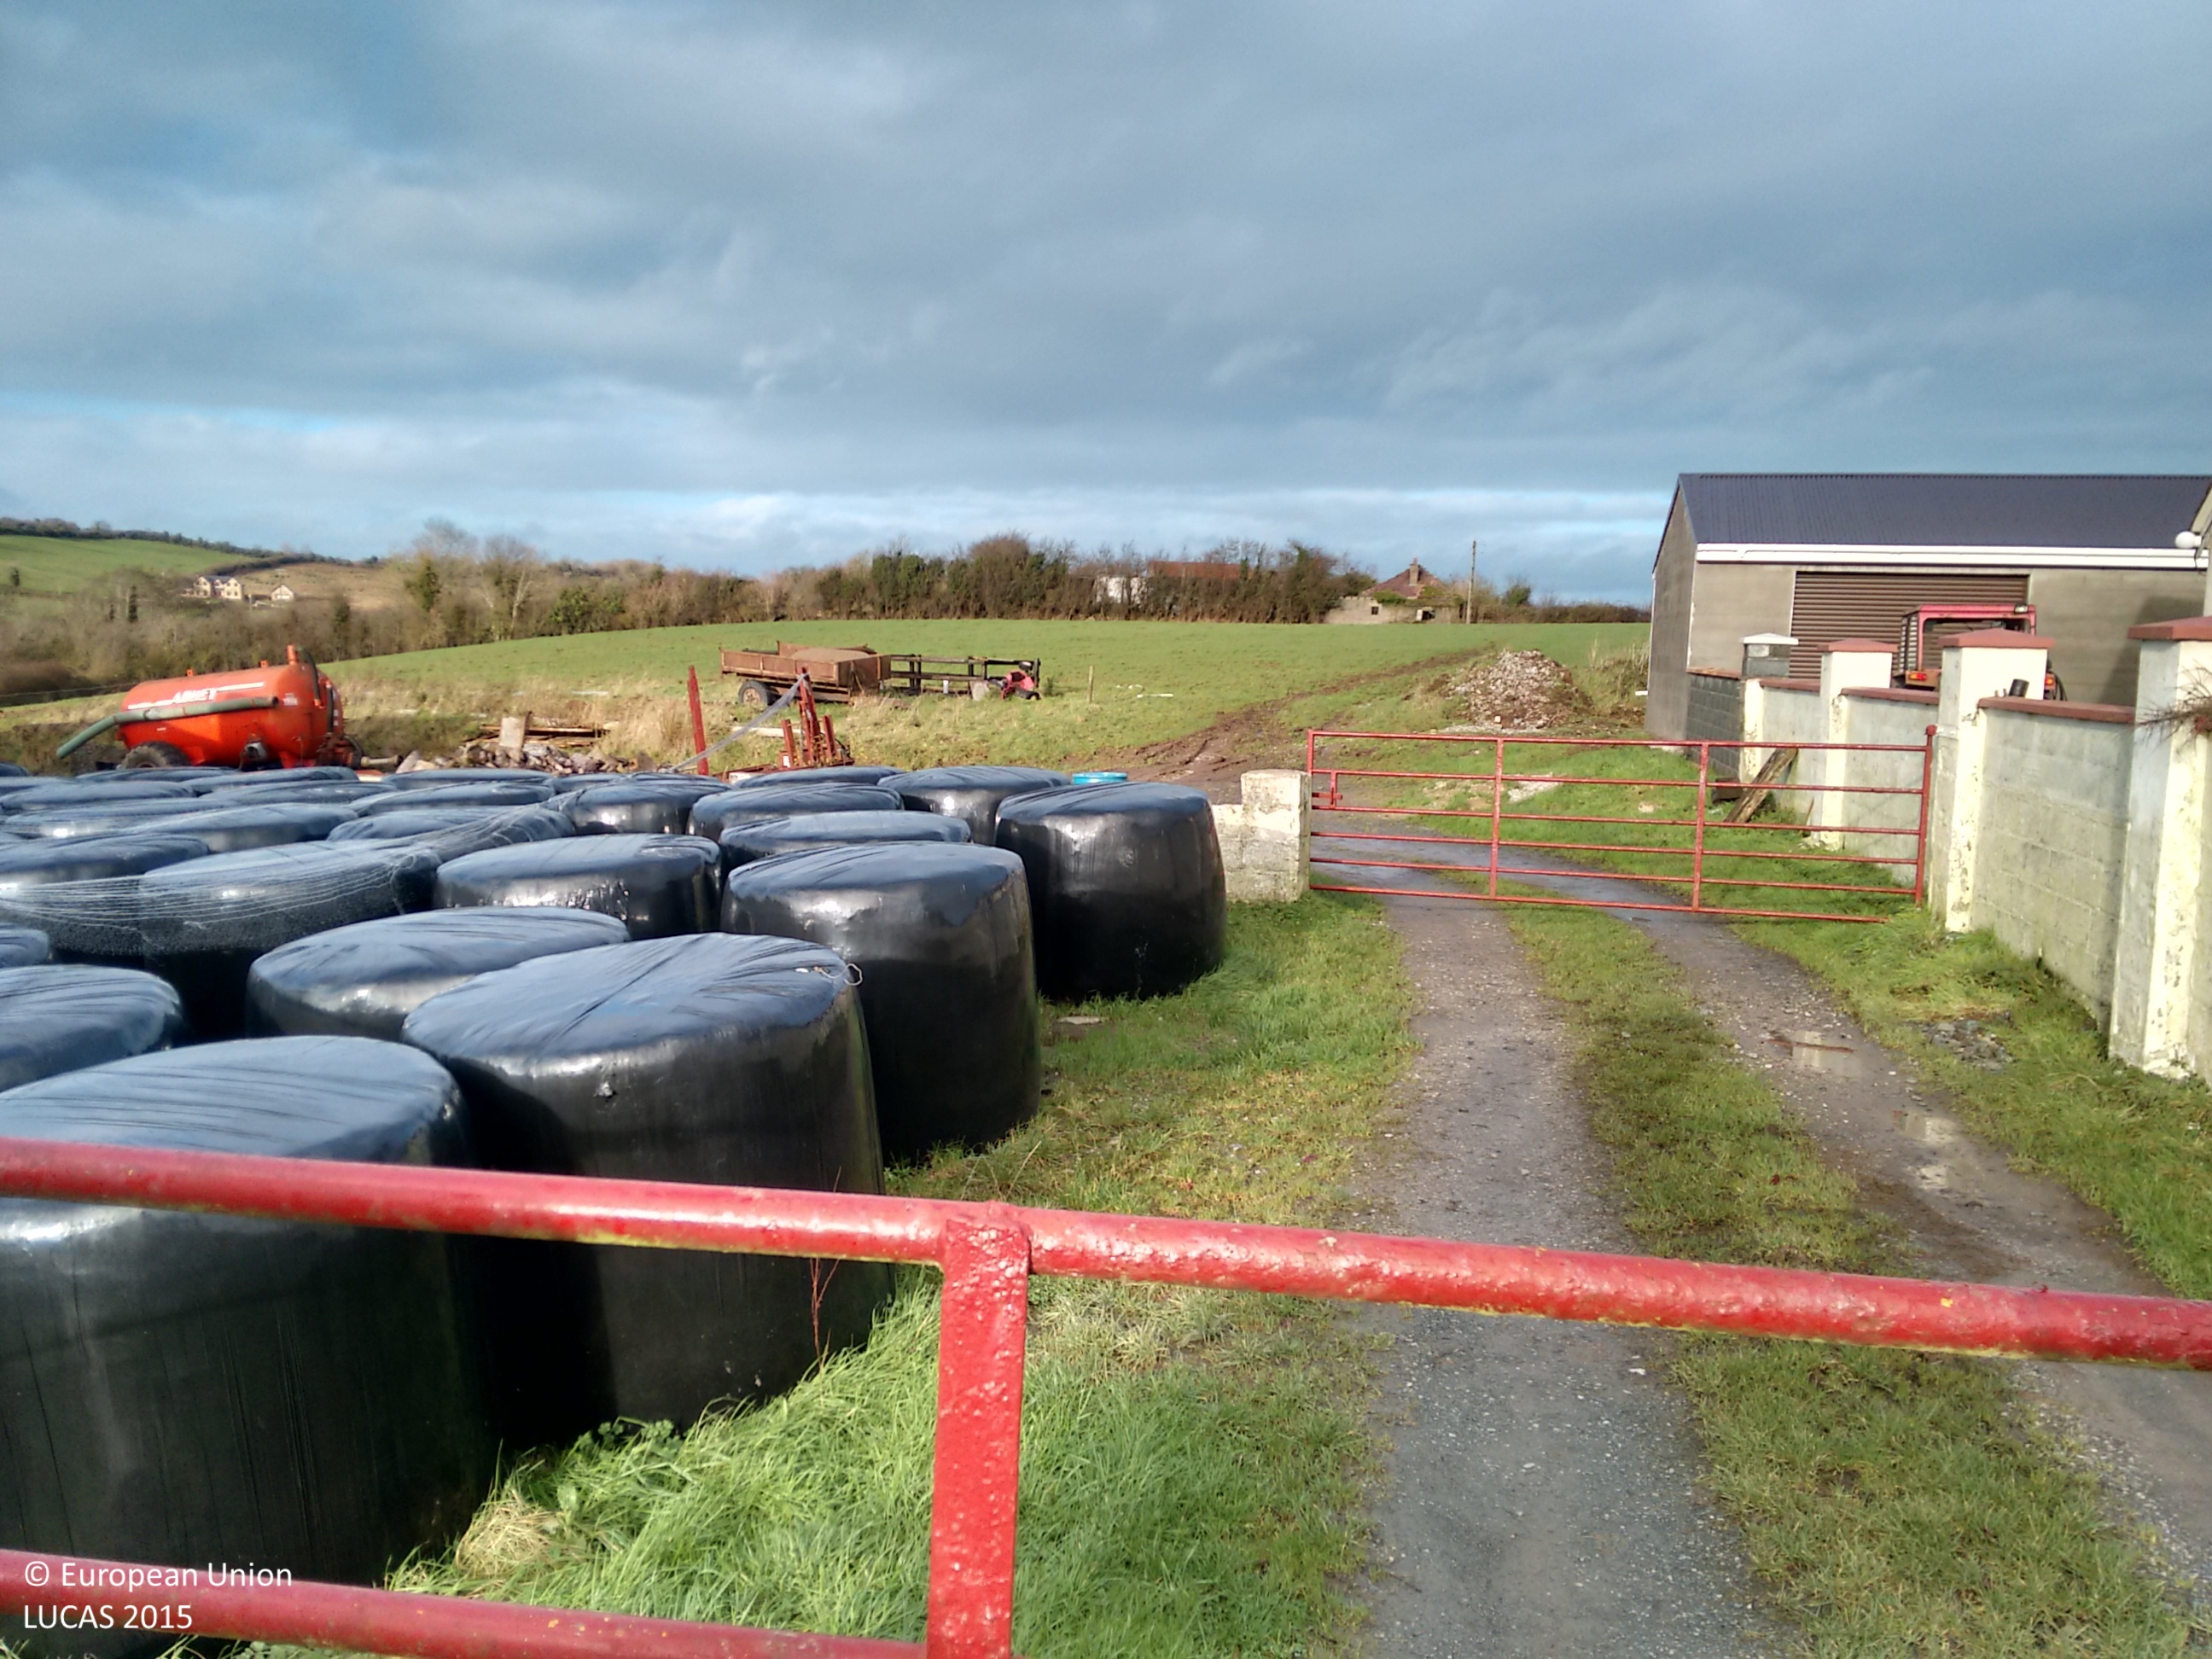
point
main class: Grassland
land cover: Grassland without tree/shrub cover
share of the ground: > 75 %
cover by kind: herbaceous plants 100 %
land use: Agriculture (excluding fallow land and kitchen gardens)
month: December
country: IE
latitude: 53.9334
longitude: -6.7507
